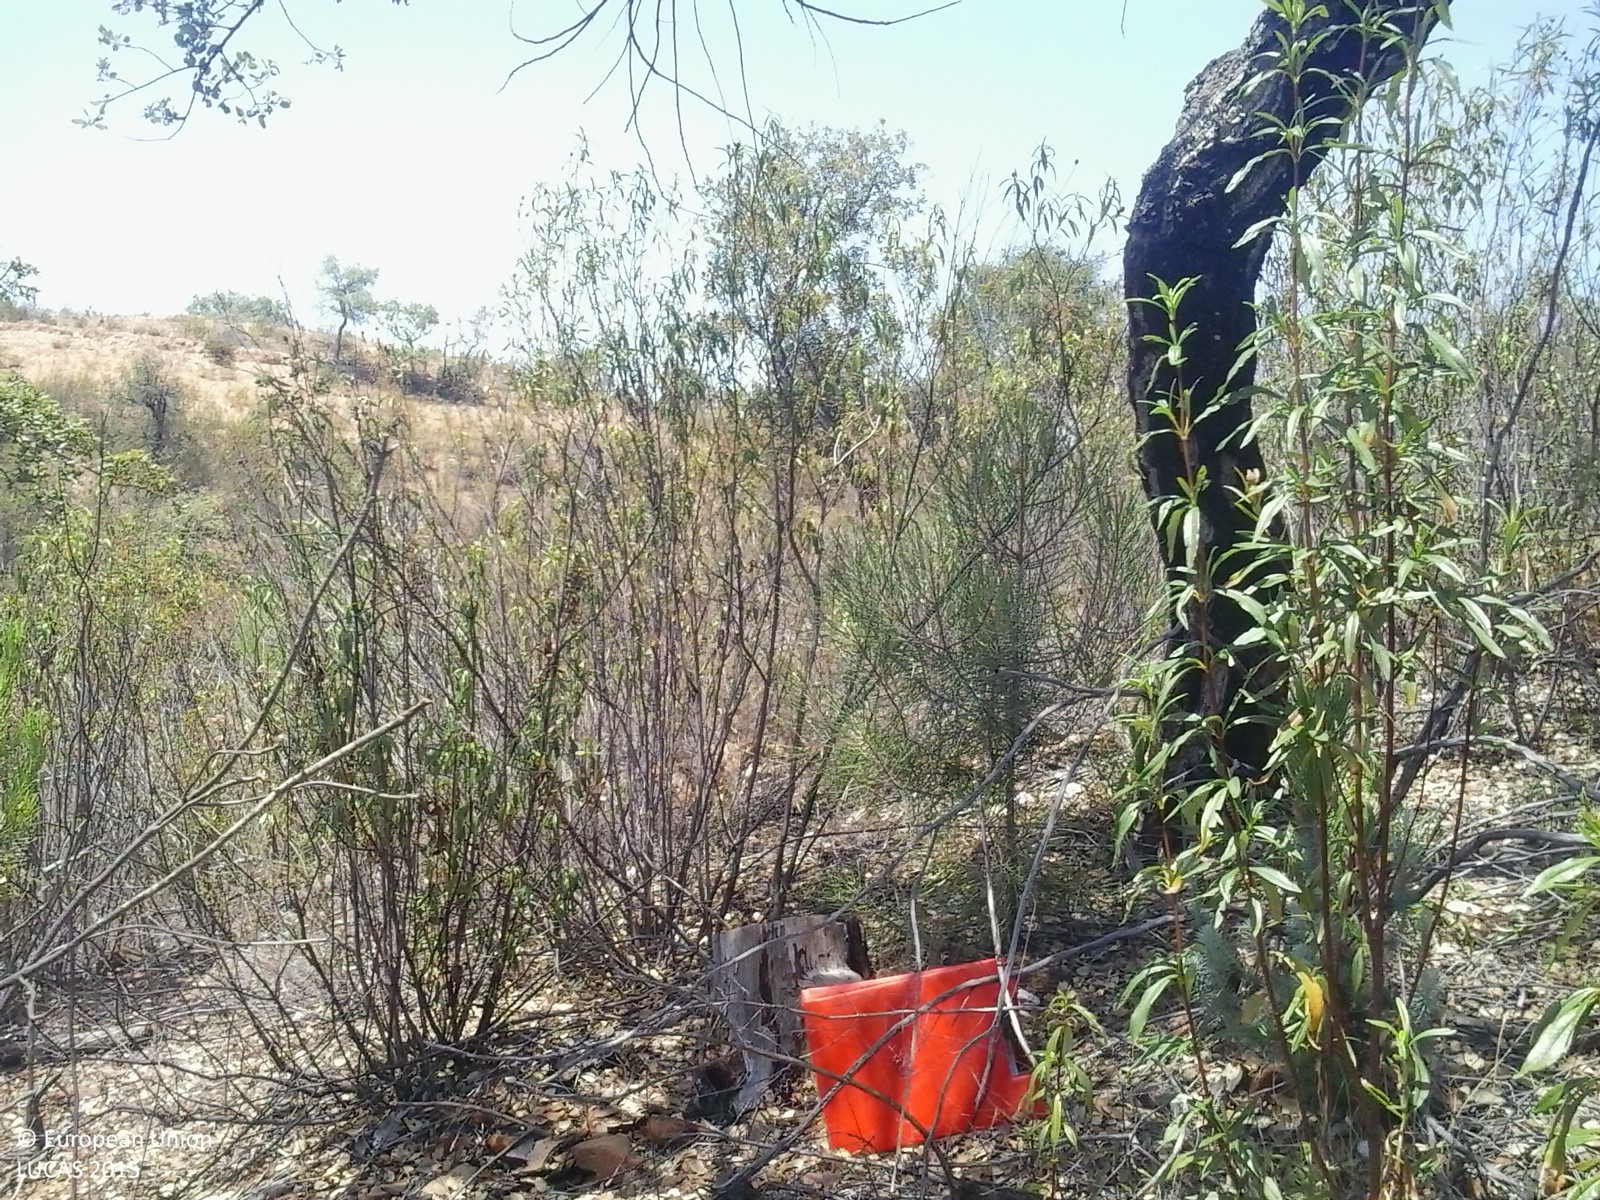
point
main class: Shrubland
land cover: Shrubland with sparse tree cover
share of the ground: > 75 %
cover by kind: shrubs 85 %, herbaceous plants 10 %, broadleaved forest trees 5 %
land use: Forestry
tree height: < 5 m
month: July
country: ES
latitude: 37.5651
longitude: -6.4164
